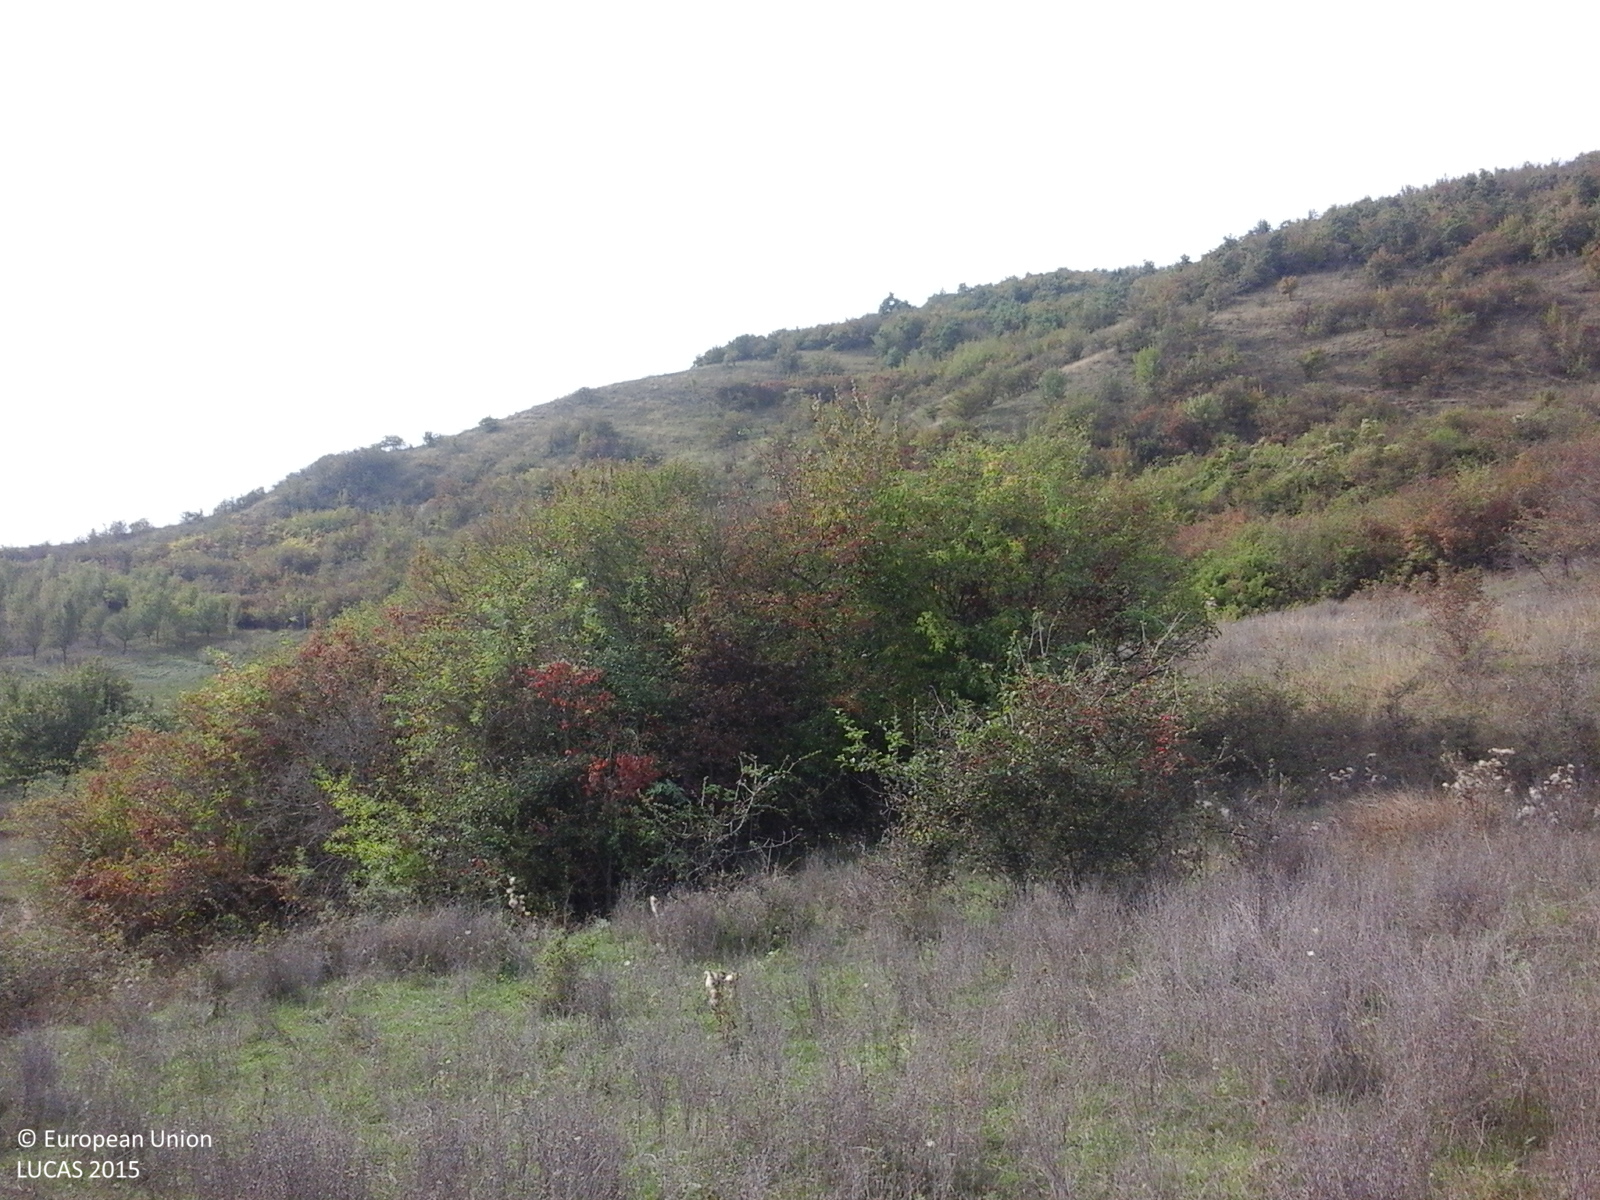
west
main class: Grassland
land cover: Spontaneously vegetated surfaces
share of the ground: > 75 %
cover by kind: herbaceous plants 100 %
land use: Fallow land
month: September
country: RO
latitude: 47.1287
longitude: 23.9617
